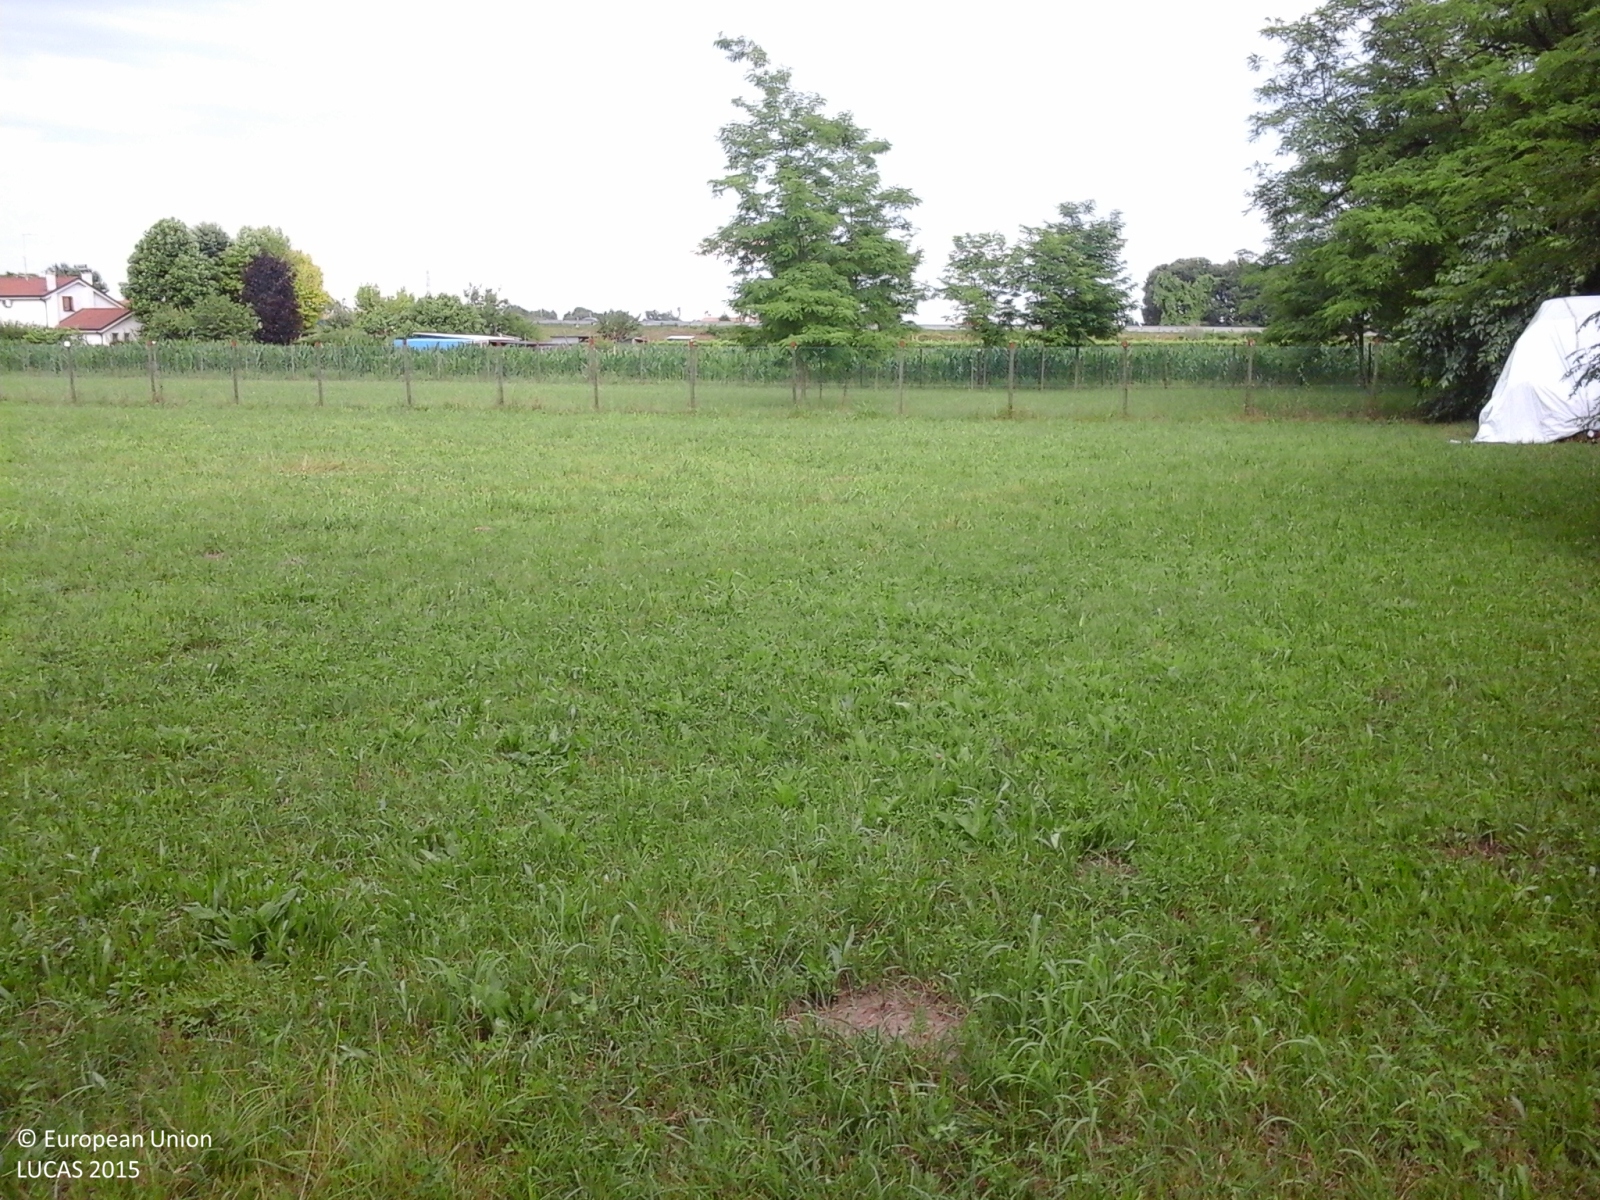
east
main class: Artificial land
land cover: Non built-up linear features
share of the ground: > 75 %
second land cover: Grassland without tree/shrub cover
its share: 10 - 25 %
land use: Road transport
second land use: Agriculture (excluding fallow land and kitchen gardens)
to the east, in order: Artificial constructions in urban areas; Managed hedges; Grassland without tree/shrub cover; Fences; Grassland without tree/shrub cover; Fences; Maize; Vineyards; Artificial constructions in urban areas
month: June
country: IT
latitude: 45.7673
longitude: 12.3241
